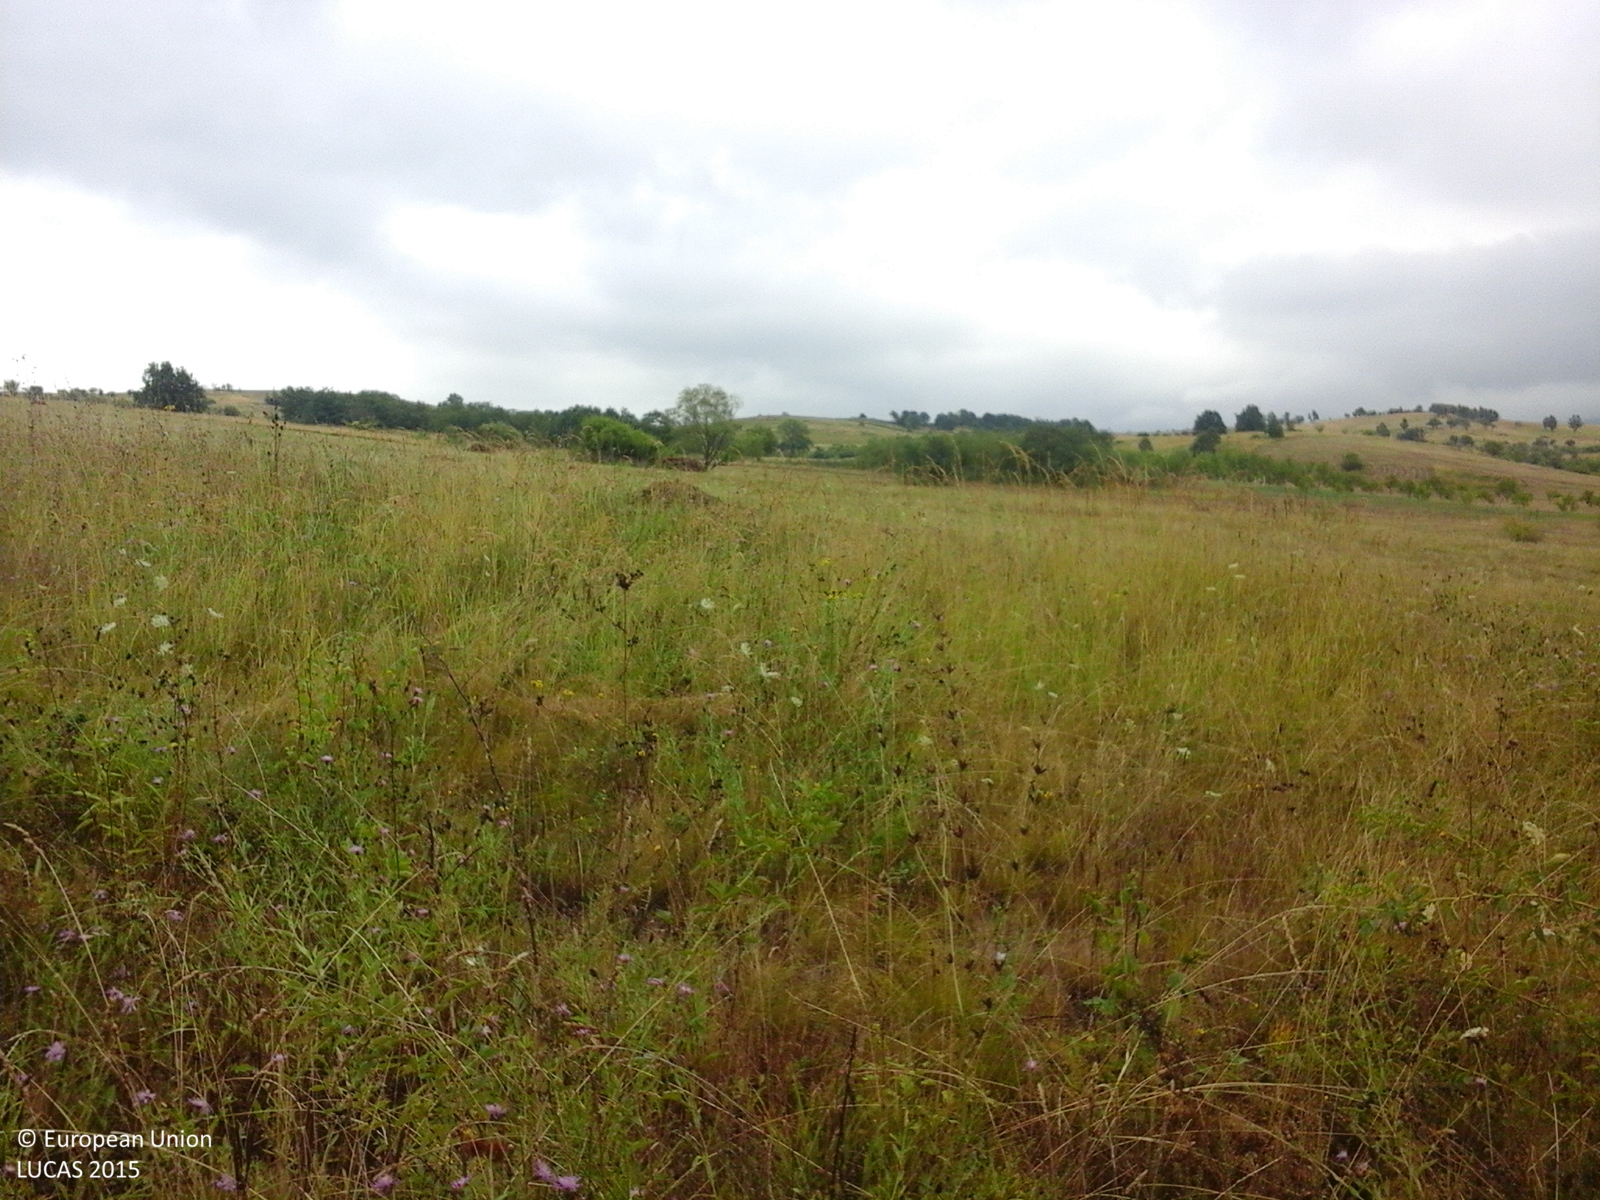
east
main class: Grassland
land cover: Grassland without tree/shrub cover
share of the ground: > 75 %
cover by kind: herbaceous plants 100 %
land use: Agriculture (excluding fallow land and kitchen gardens)
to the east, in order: Grassland without tree/shrub cover; Tracks; Grassland without tree/shrub cover; Single bushes/trees; Grassland without tree/shrub cover
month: August
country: RO
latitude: 44.8694
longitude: 22.0210
